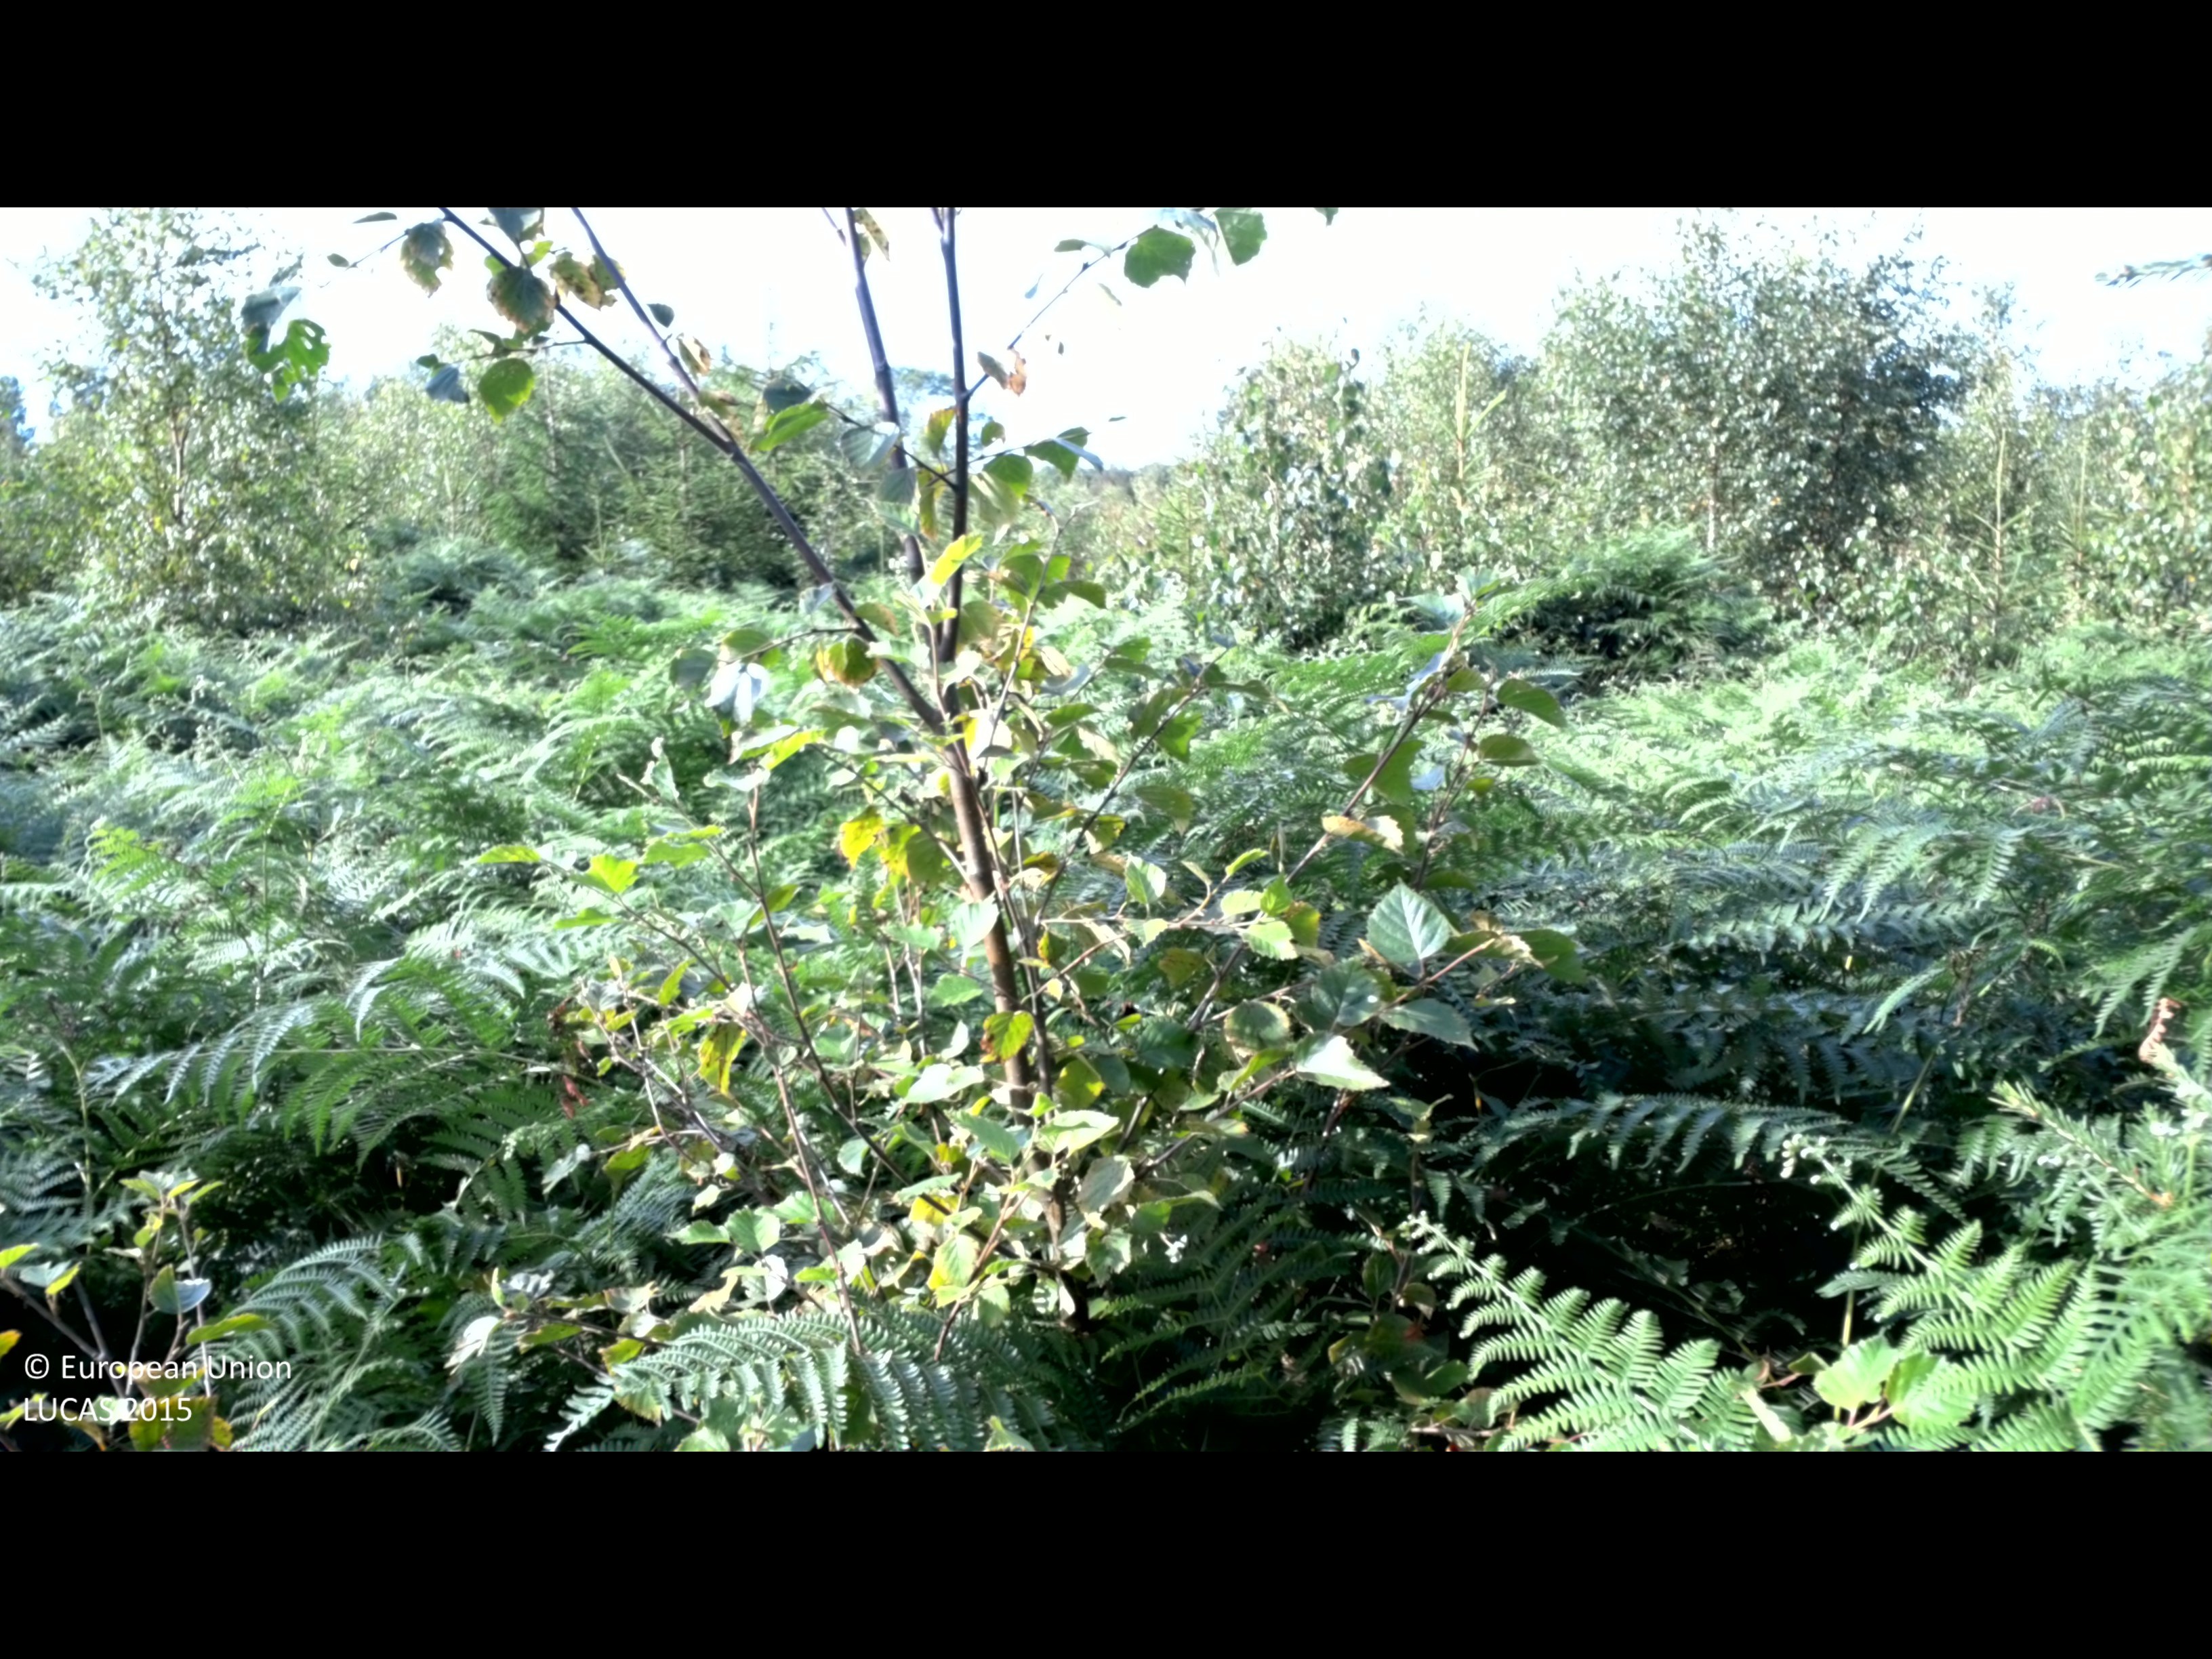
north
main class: Woodland
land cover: Spruce dominated mixed woodland
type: boreal forest
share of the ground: 50 - 75 %
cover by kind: herbaceous plants 50 %, coniferous forest trees 35 %, broadleaved forest trees 15 %
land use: Forestry
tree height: < 5 m
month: August
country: SE
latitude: 56.2194
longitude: 15.7896
